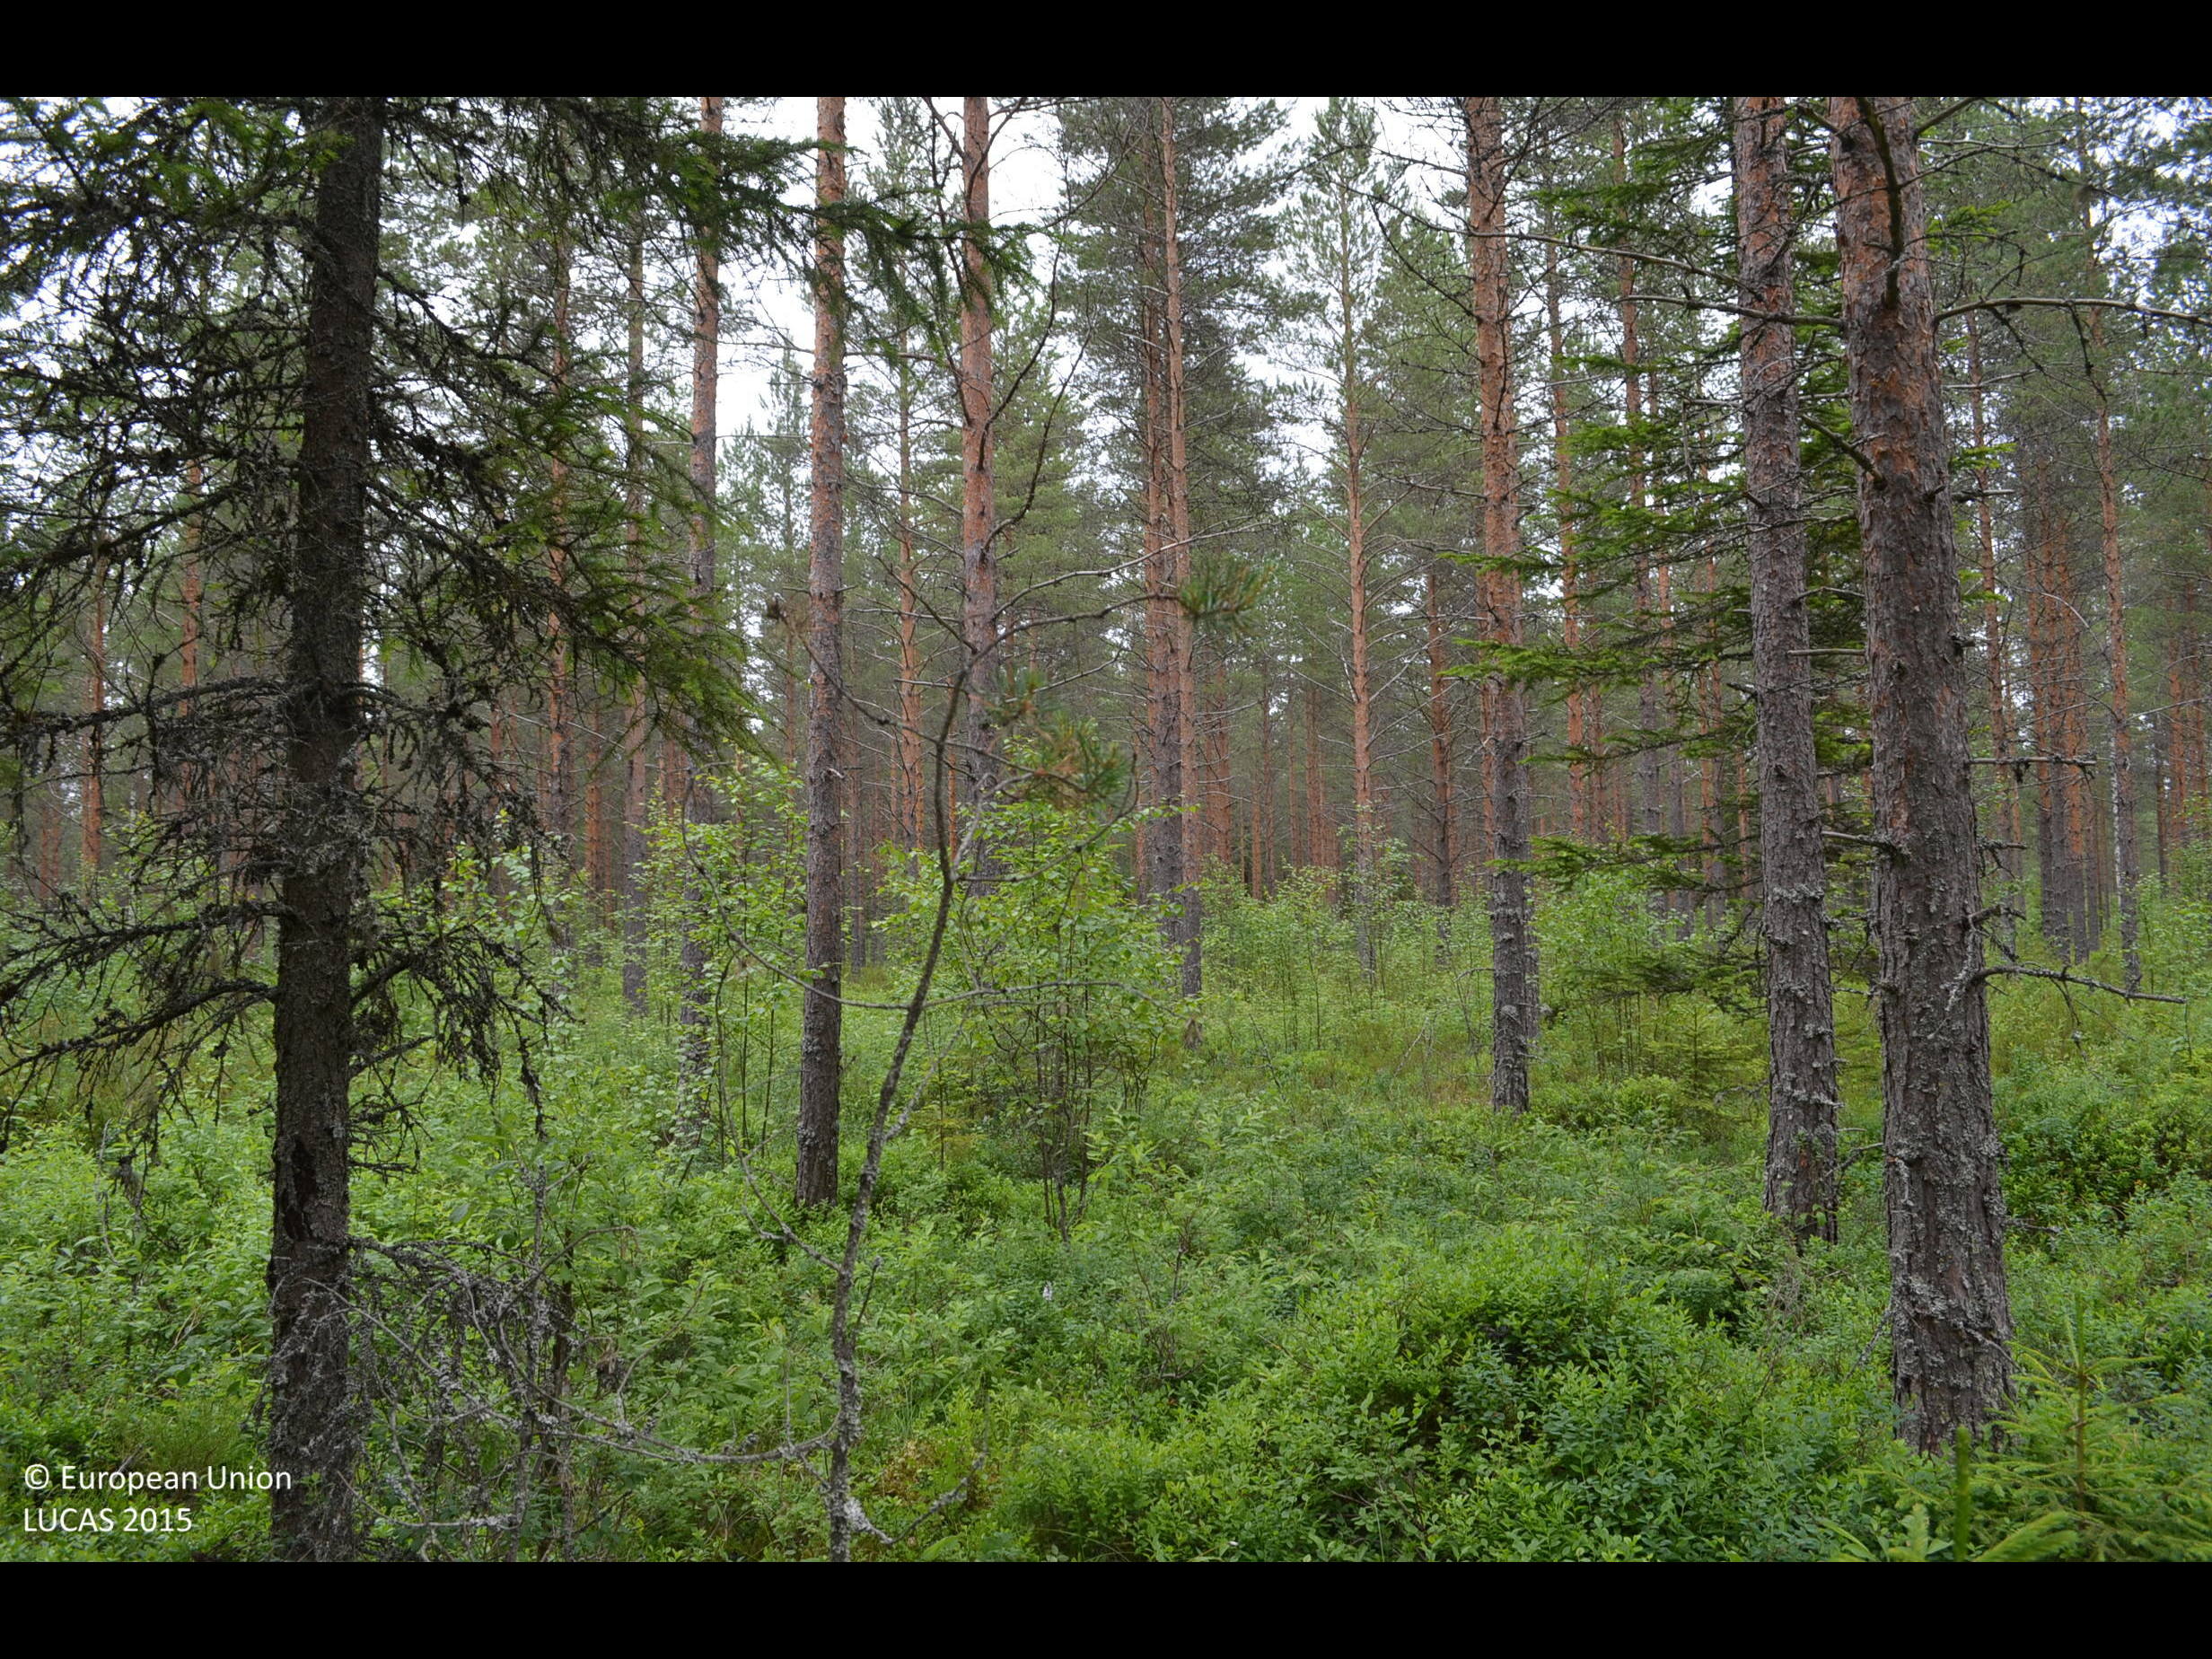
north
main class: Woodland
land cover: Pine dominated coniferous woodland
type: boreal forest
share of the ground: 50 - 75 %
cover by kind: coniferous forest trees 55 %, shrubs 35 %, broadleaved forest trees 10 %
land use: Forestry
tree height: > 5 m
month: July
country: FI
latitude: 62.2722
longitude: 23.5405
